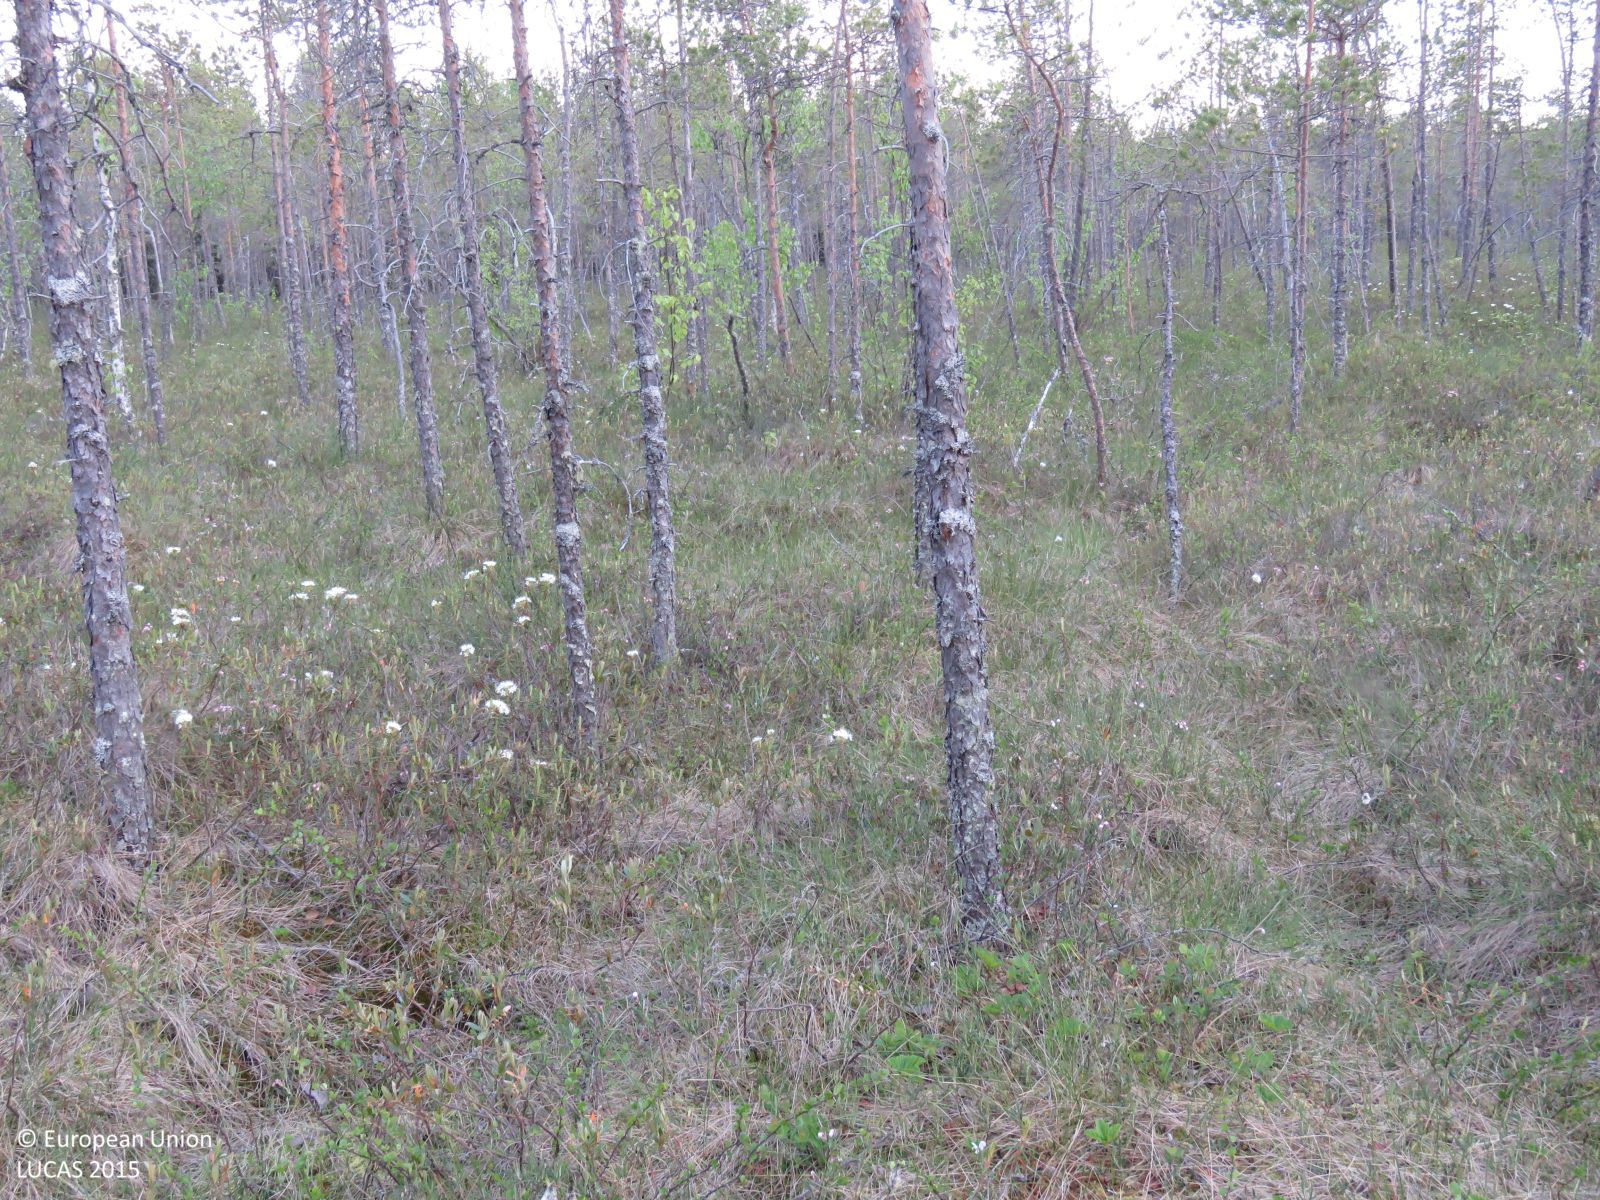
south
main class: Woodland
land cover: Pine dominated coniferous woodland
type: mire and swamp forests
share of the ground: 25 - 50 %
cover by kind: shrubs 55 %, coniferous forest trees 30 %, broadleaved forest trees 5 %, herbaceous plants 5 %, lichens and mosses 5 %
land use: Forestry
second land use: Amenities, museums, leisure
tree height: > 5 m
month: June
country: FI
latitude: 64.8076
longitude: 26.2969
